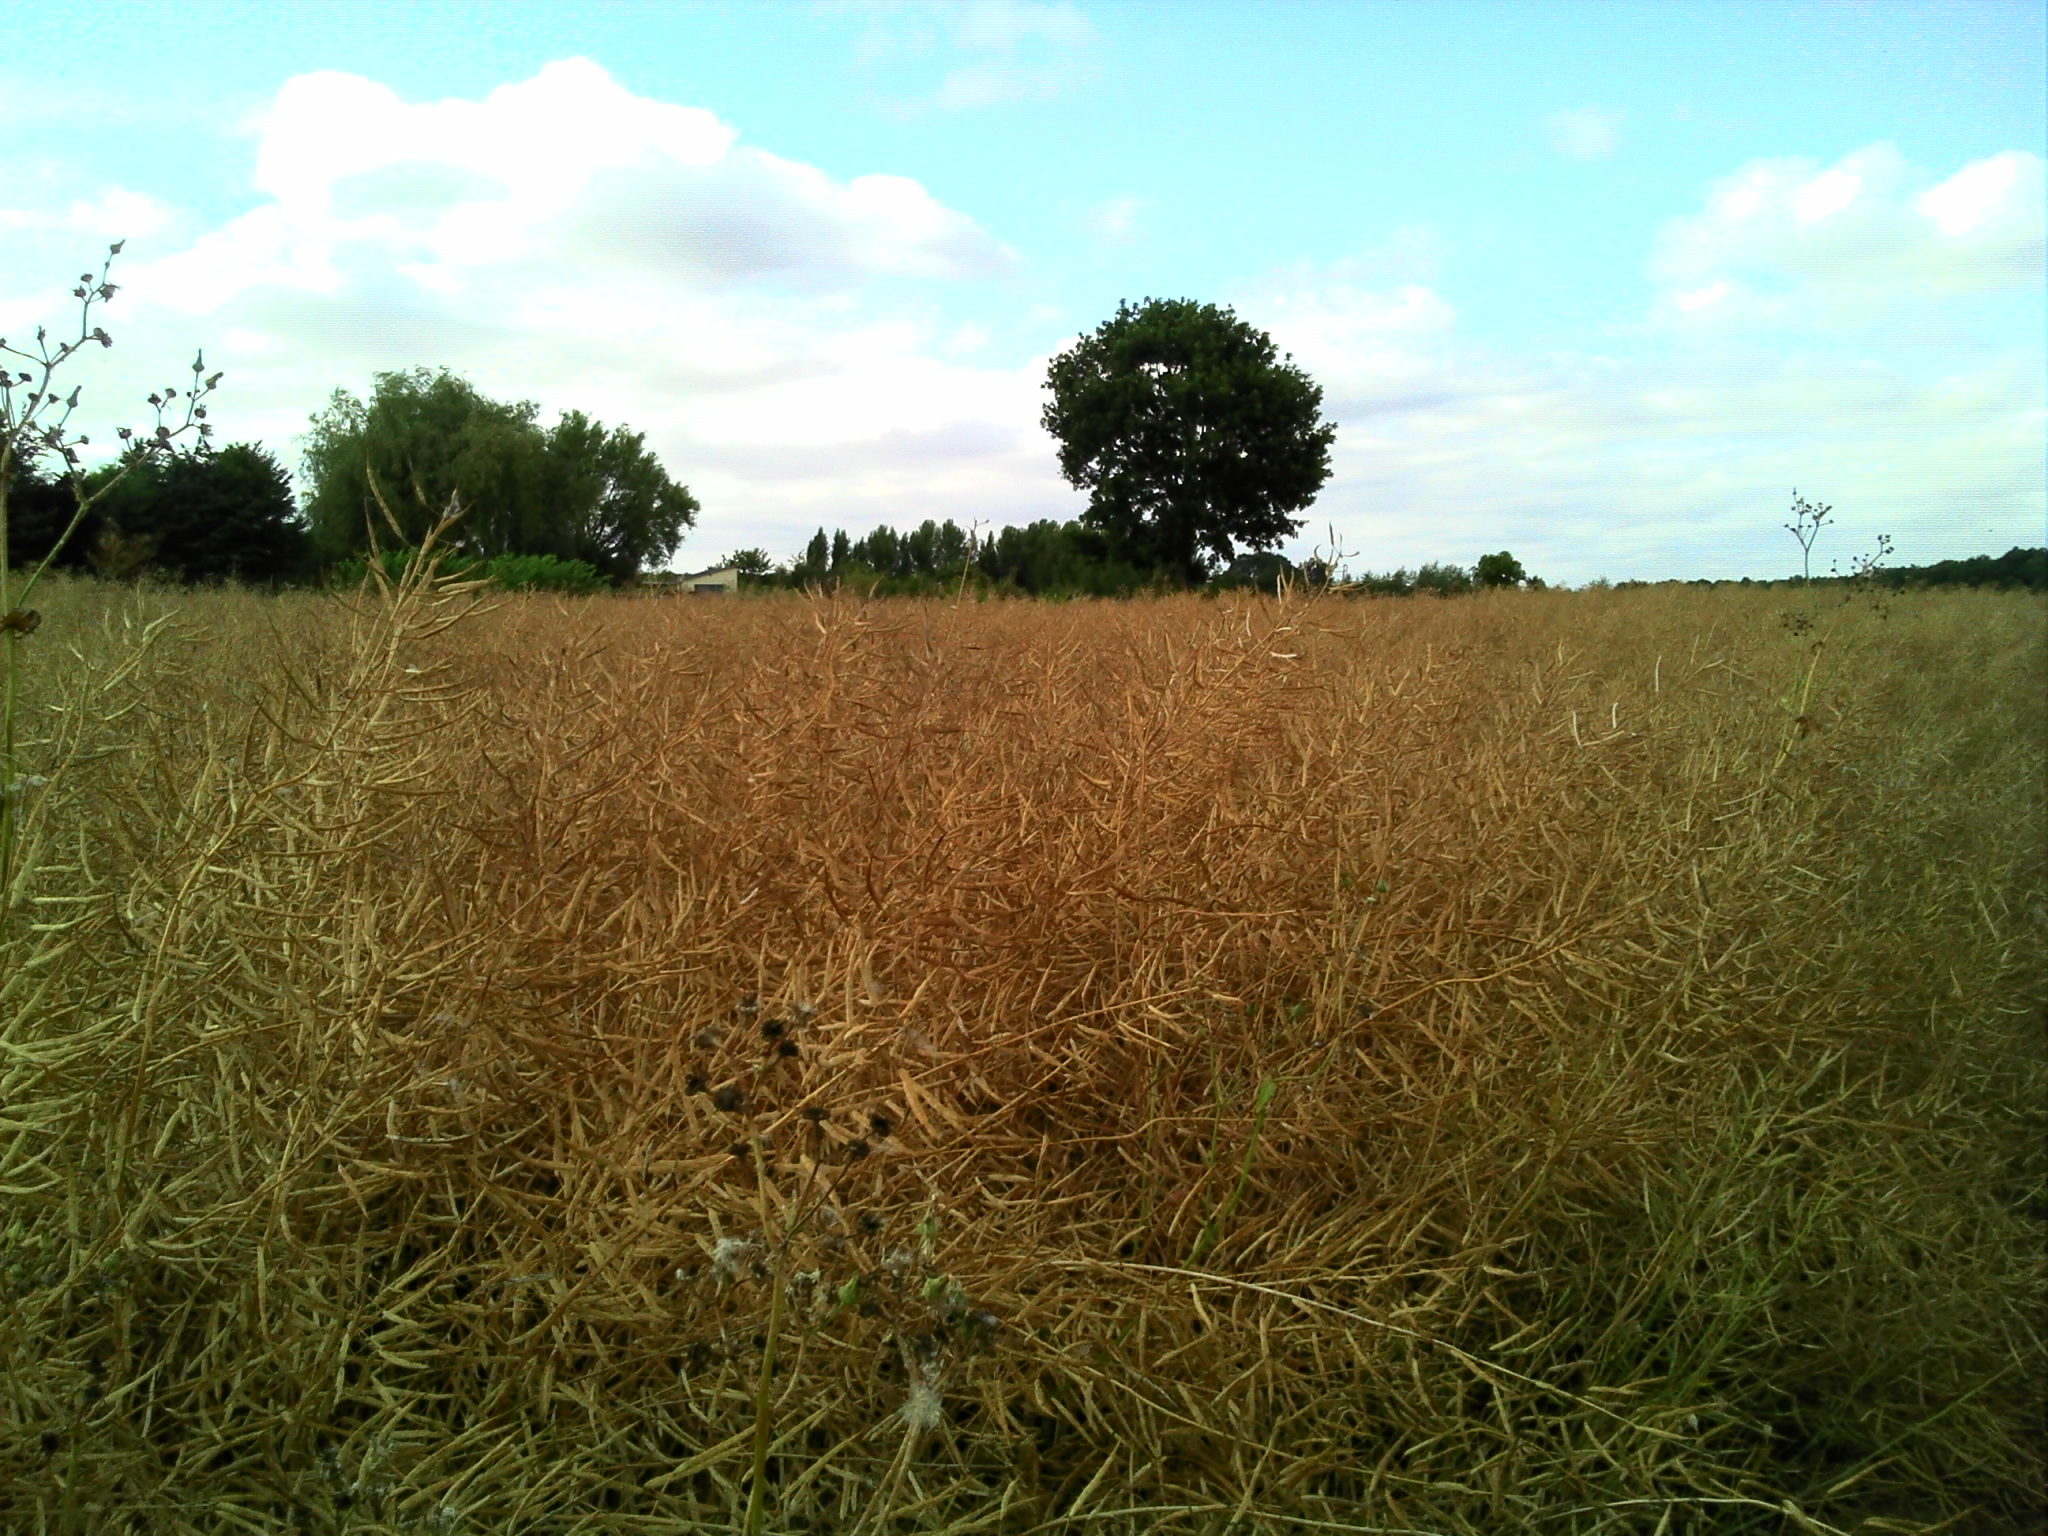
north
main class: Cropland
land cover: Rape and turnip rape
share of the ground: > 75 %
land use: Agriculture (excluding fallow land and kitchen gardens)
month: July
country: FR
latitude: 48.9482
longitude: 1.0900
